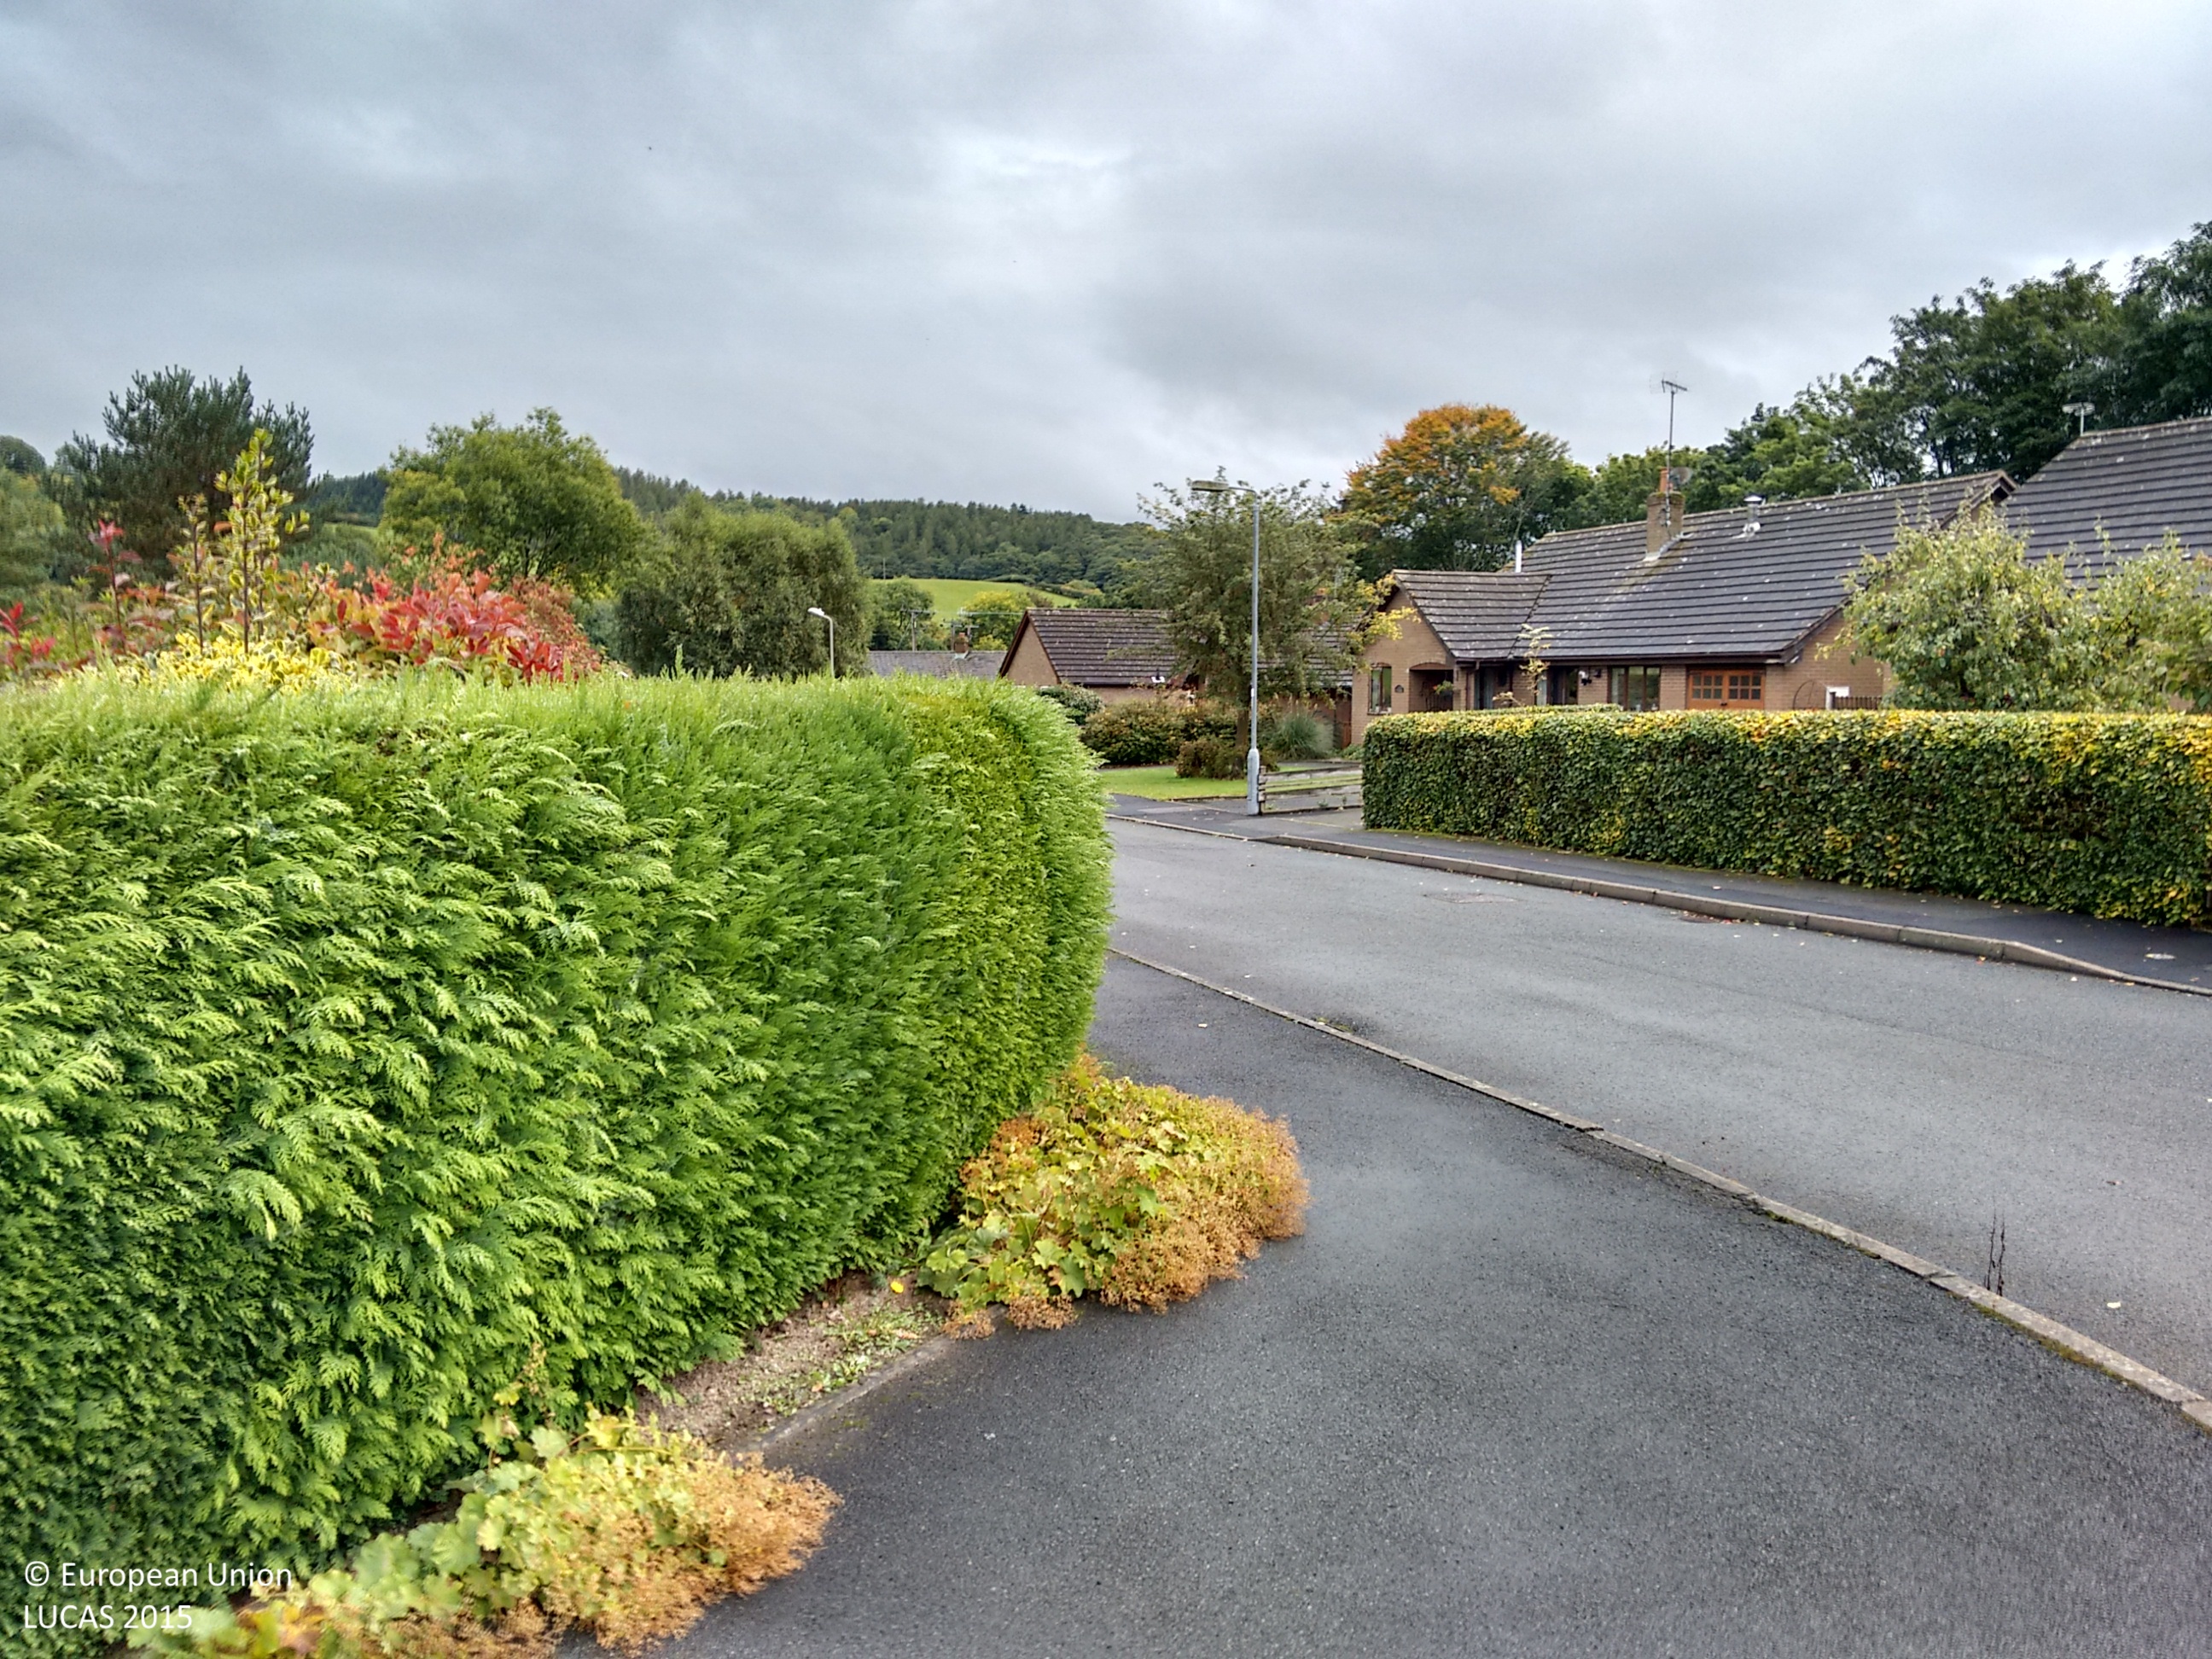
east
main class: Grassland
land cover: Grassland without tree/shrub cover
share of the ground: > 75 %
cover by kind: herbaceous plants 100 %
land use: Residential
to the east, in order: Grassland without tree/shrub cover; Artificial constructions in urban areas; Managed hedges; Fences; Grassland without tree/shrub cover; Electric lines; Grassland without tree/shrub cover; Fences; Managed hedges; Grassland with sparse tree/shrub cover
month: October
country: GB
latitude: 52.2940
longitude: -3.0222
